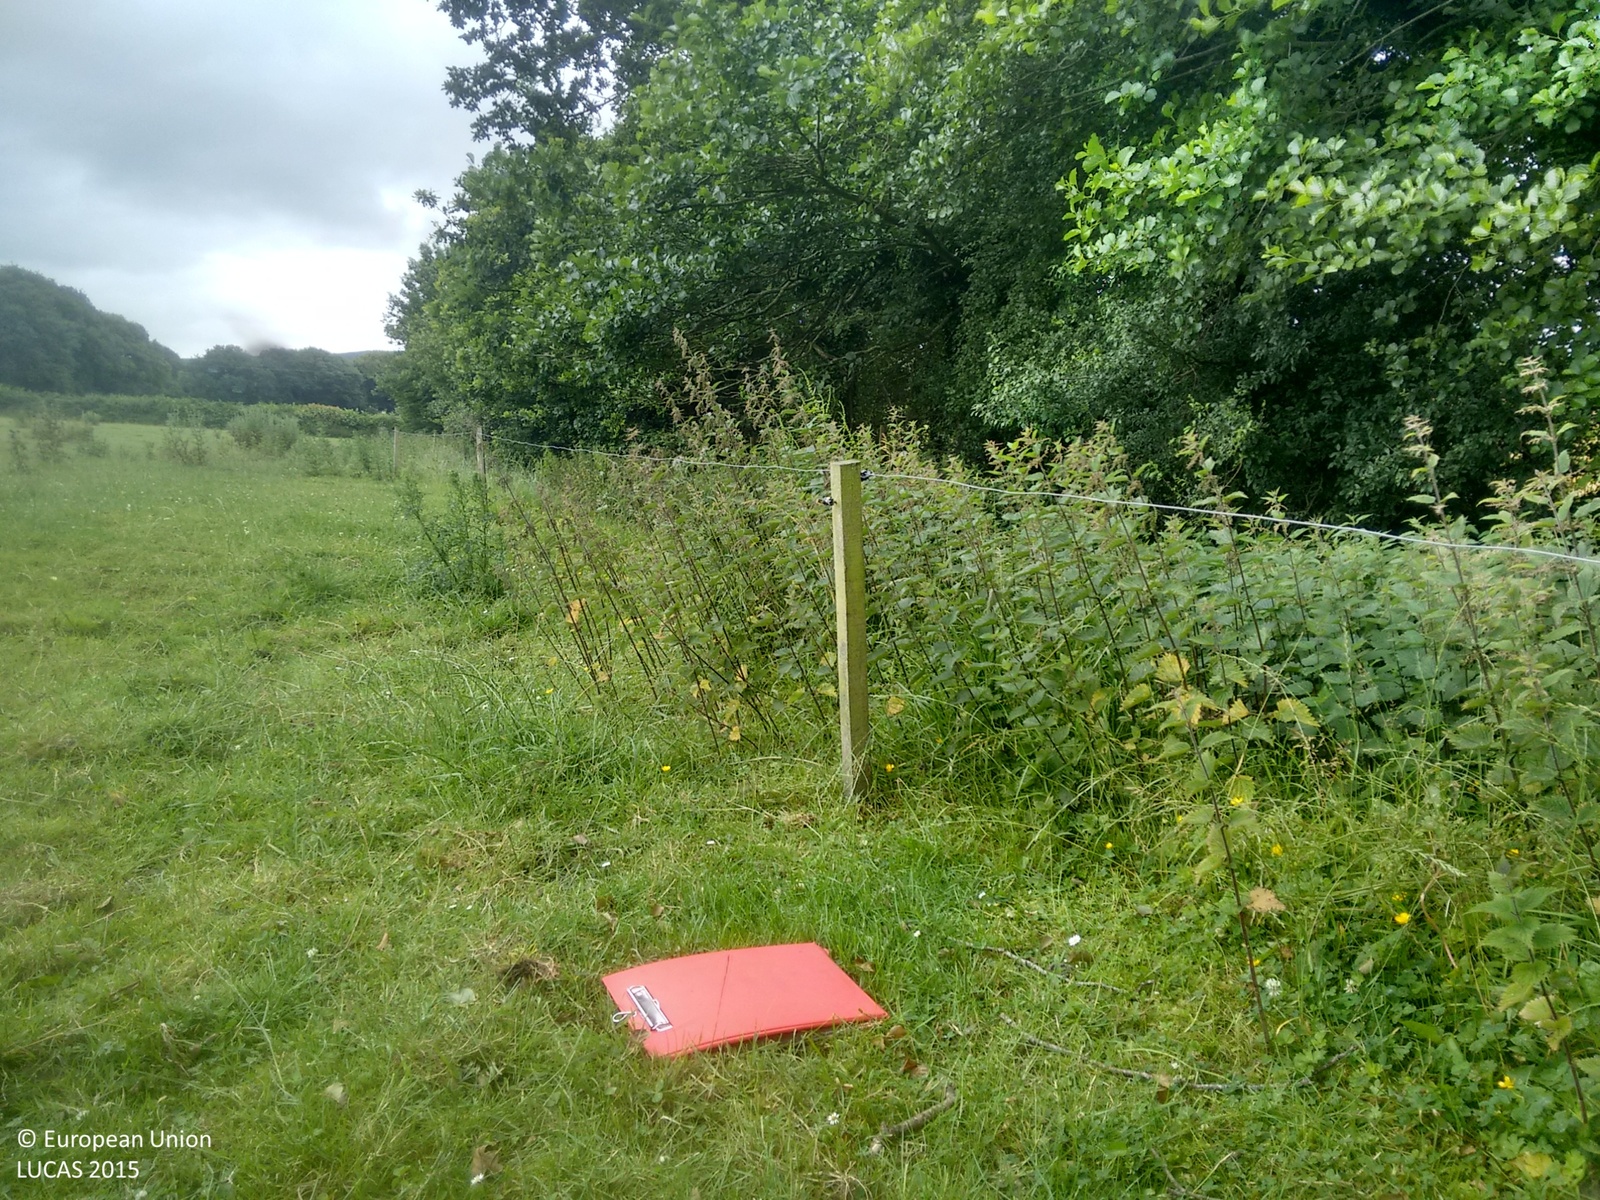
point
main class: Grassland
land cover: Grassland without tree/shrub cover
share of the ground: > 75 %
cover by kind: herbaceous plants 100 %
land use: Agriculture (excluding fallow land and kitchen gardens)
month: July
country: IE
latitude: 52.7691
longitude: -6.6583
